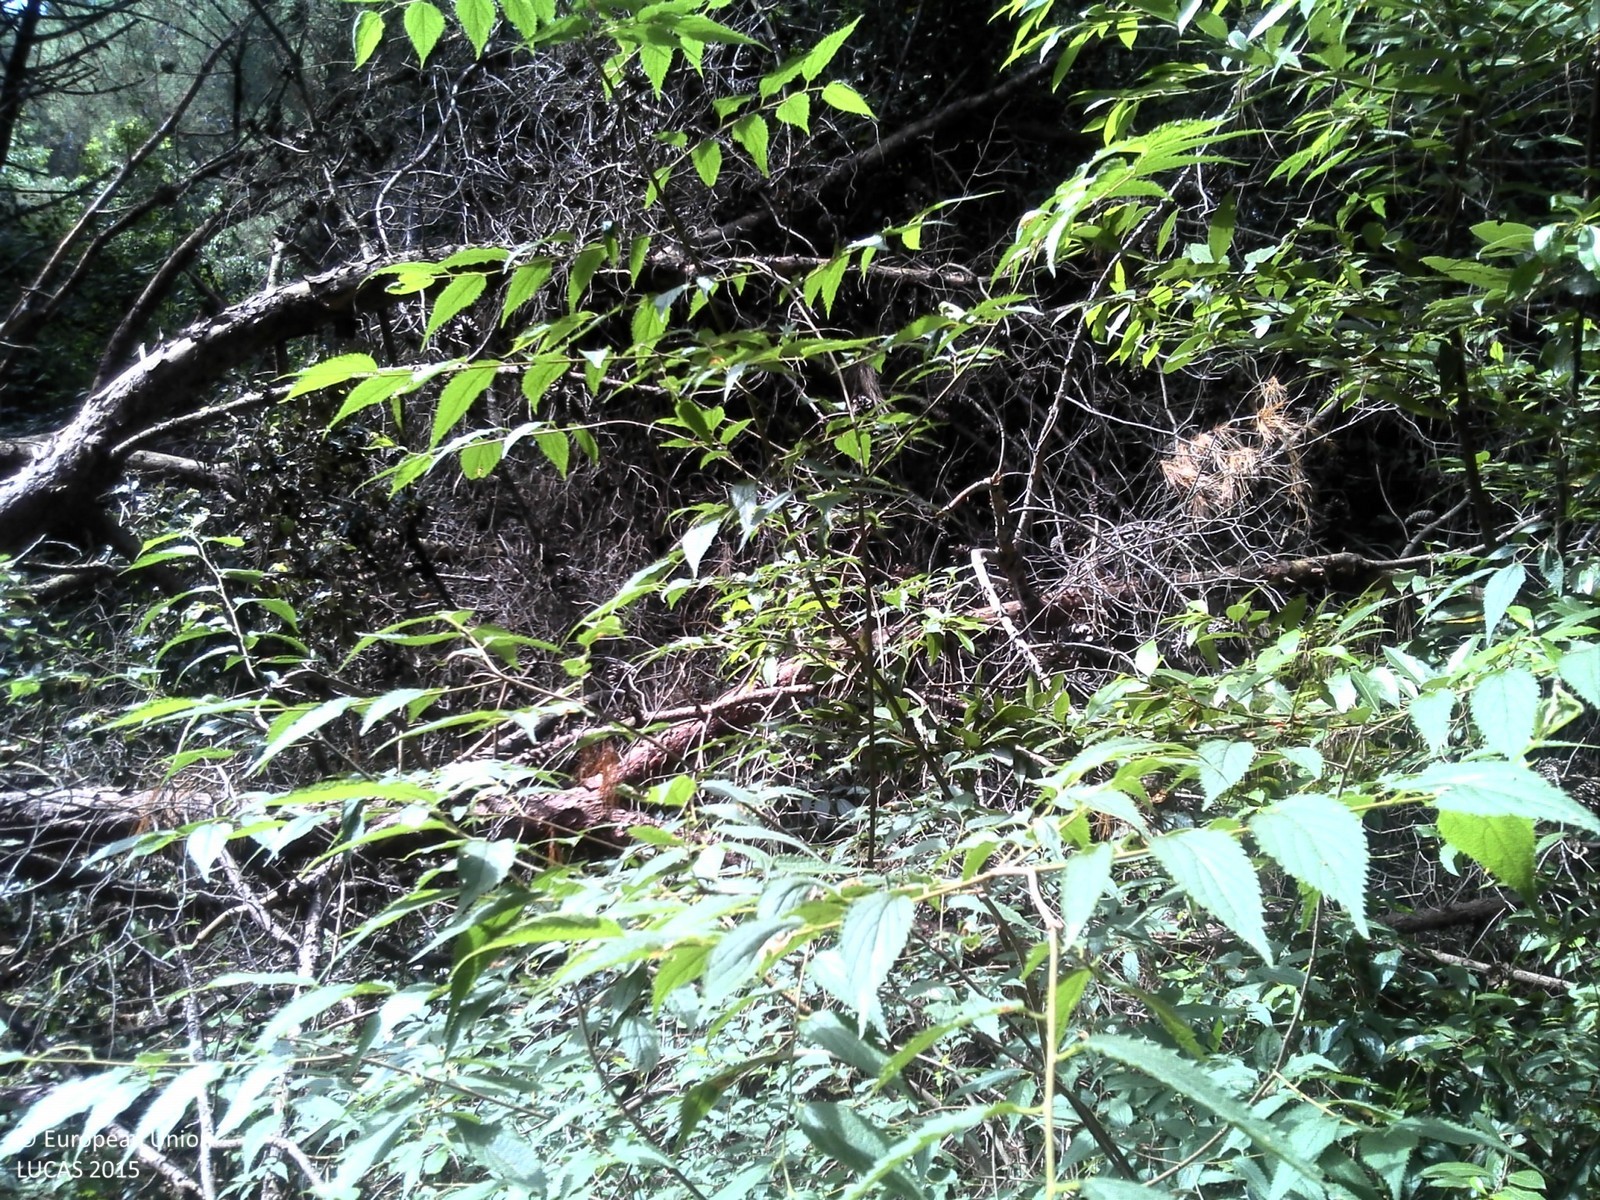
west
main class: Woodland
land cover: Other coniferous woodland
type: coniferous forest of the mediterranean region
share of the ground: > 75 %
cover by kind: coniferous forest trees 85 %, shrubs 10 %, broadleaved forest trees 5 %
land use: Sport
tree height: > 5 m
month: June
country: HR
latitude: 44.8576
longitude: 13.8284
